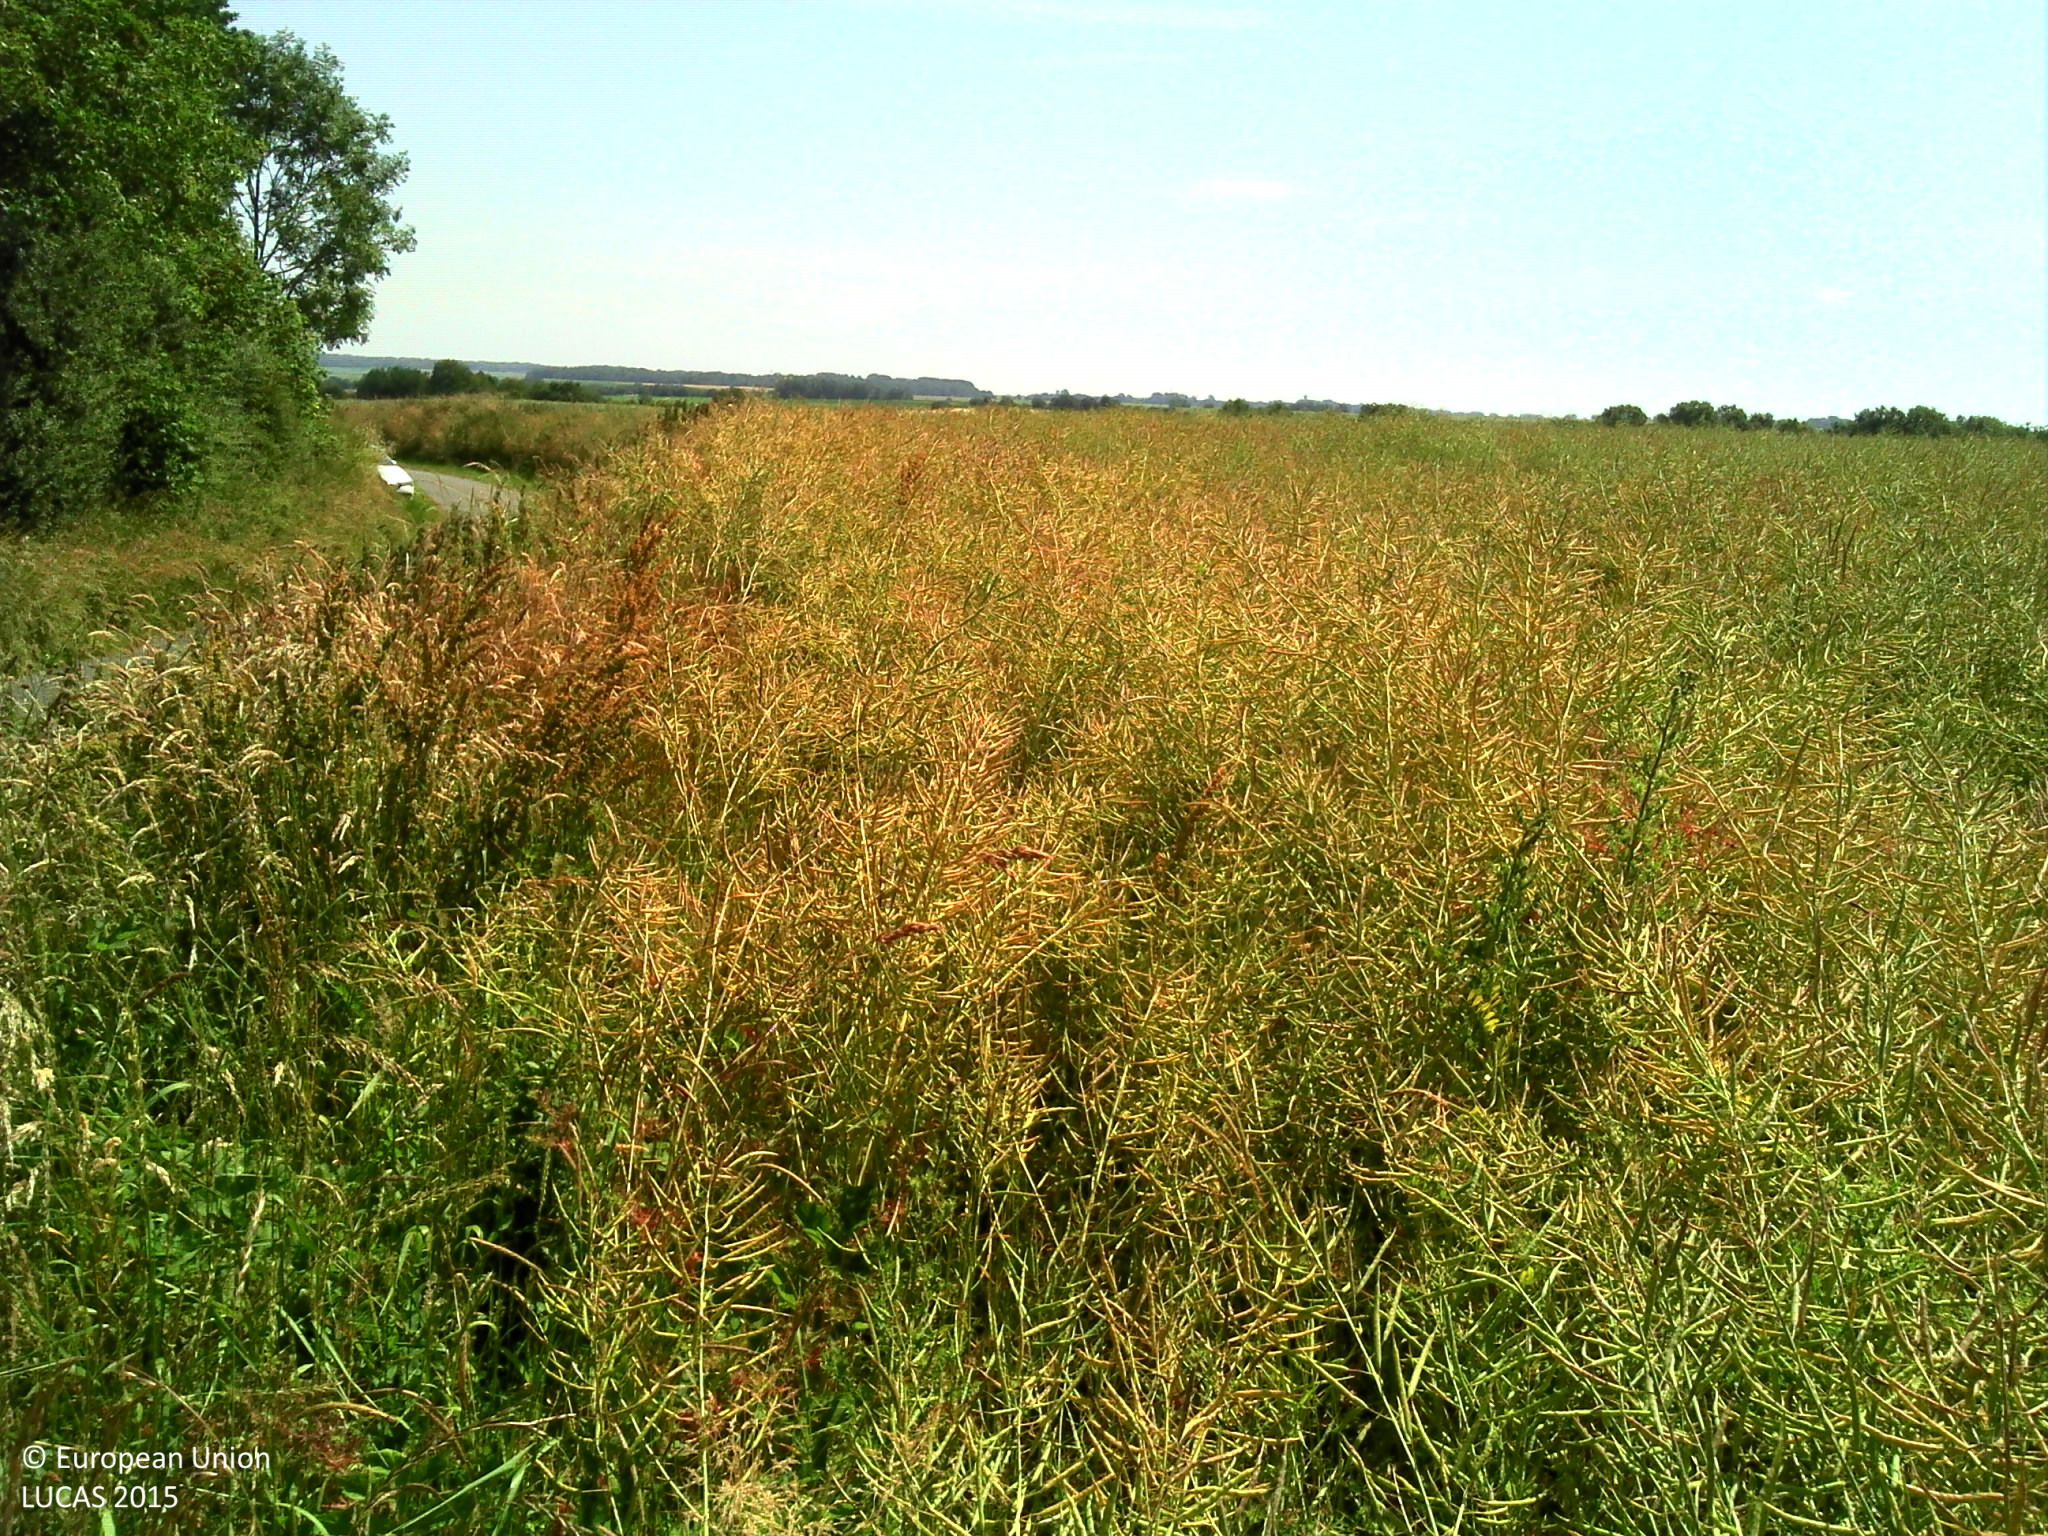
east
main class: Cropland
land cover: Rape and turnip rape
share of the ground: > 75 %
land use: Agriculture (excluding fallow land and kitchen gardens)
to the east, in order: Rape and turnip rape; Common wheat
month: July
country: FR
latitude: 50.2517
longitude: 2.3431
